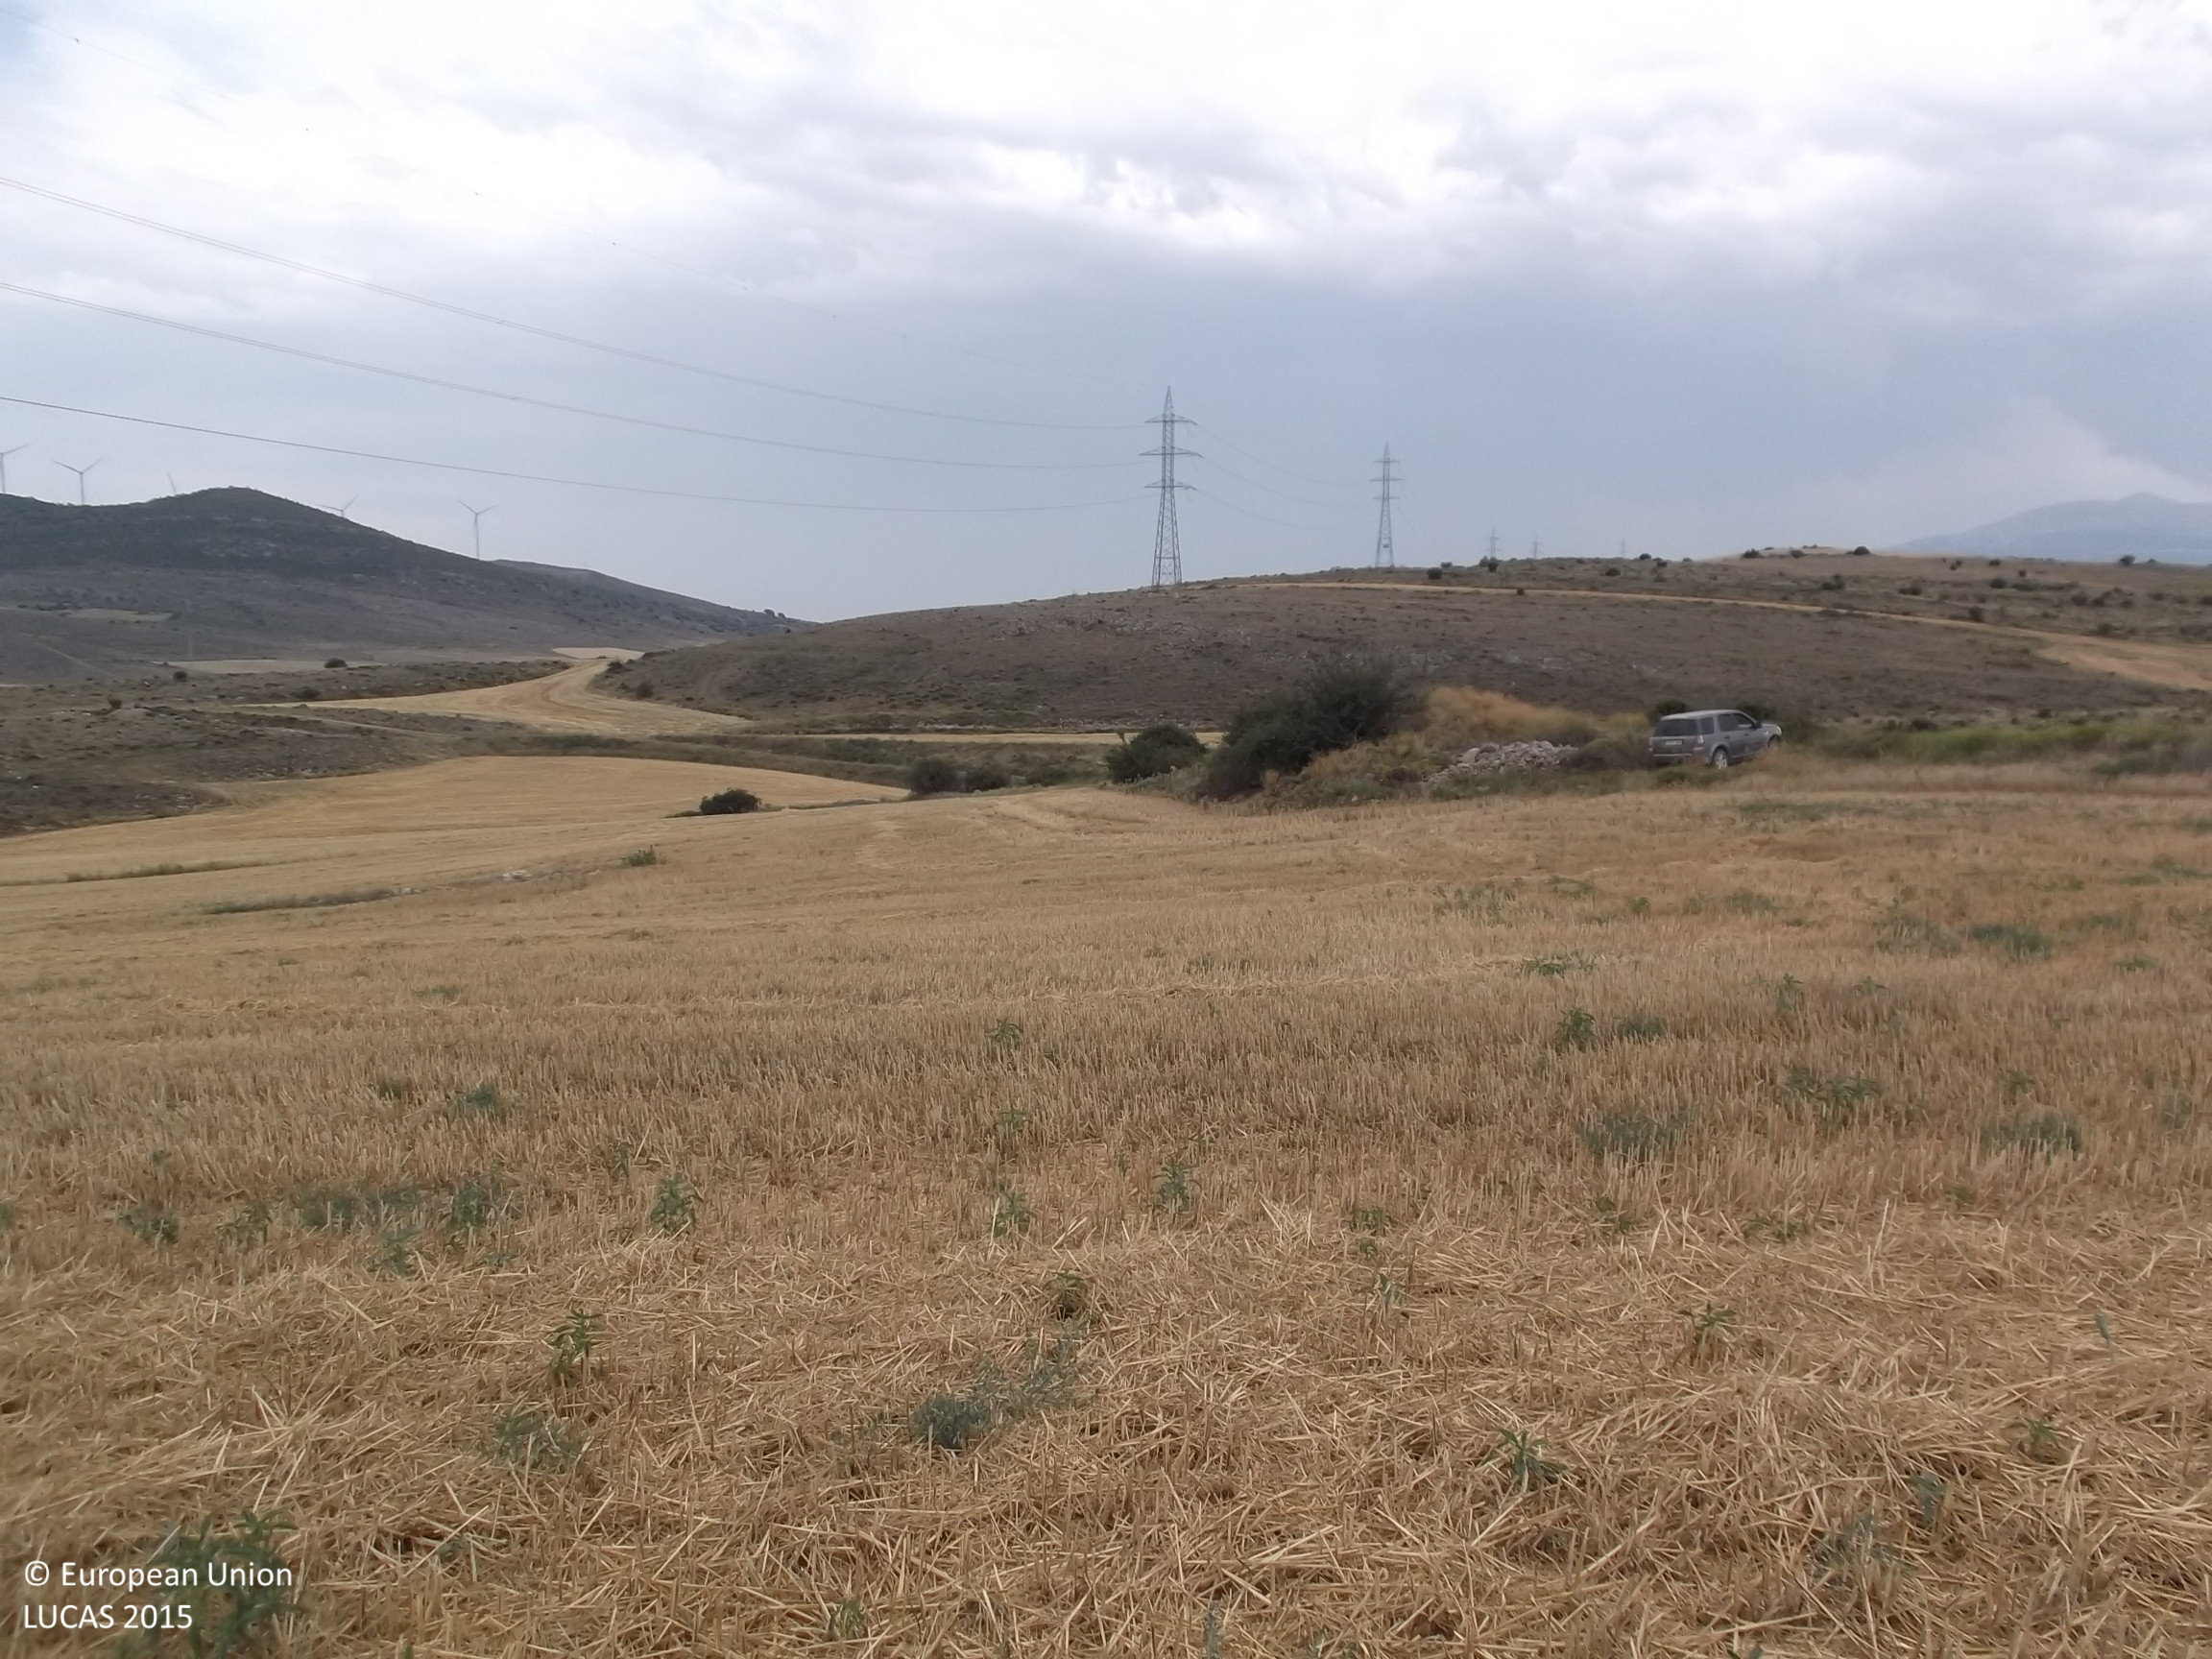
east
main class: Cropland
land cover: Common wheat
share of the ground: < 10 %
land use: Agriculture (excluding fallow land and kitchen gardens)
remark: Harvested field
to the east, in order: Common wheat; Shrubland without tree cover; Common wheat; Grass margins; Tracks; Grassland without tree/shrub cover; Barley; Grass margins; Tracks; Shrubland without tree cover
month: July
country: ES
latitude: 41.8474
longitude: -1.9934
